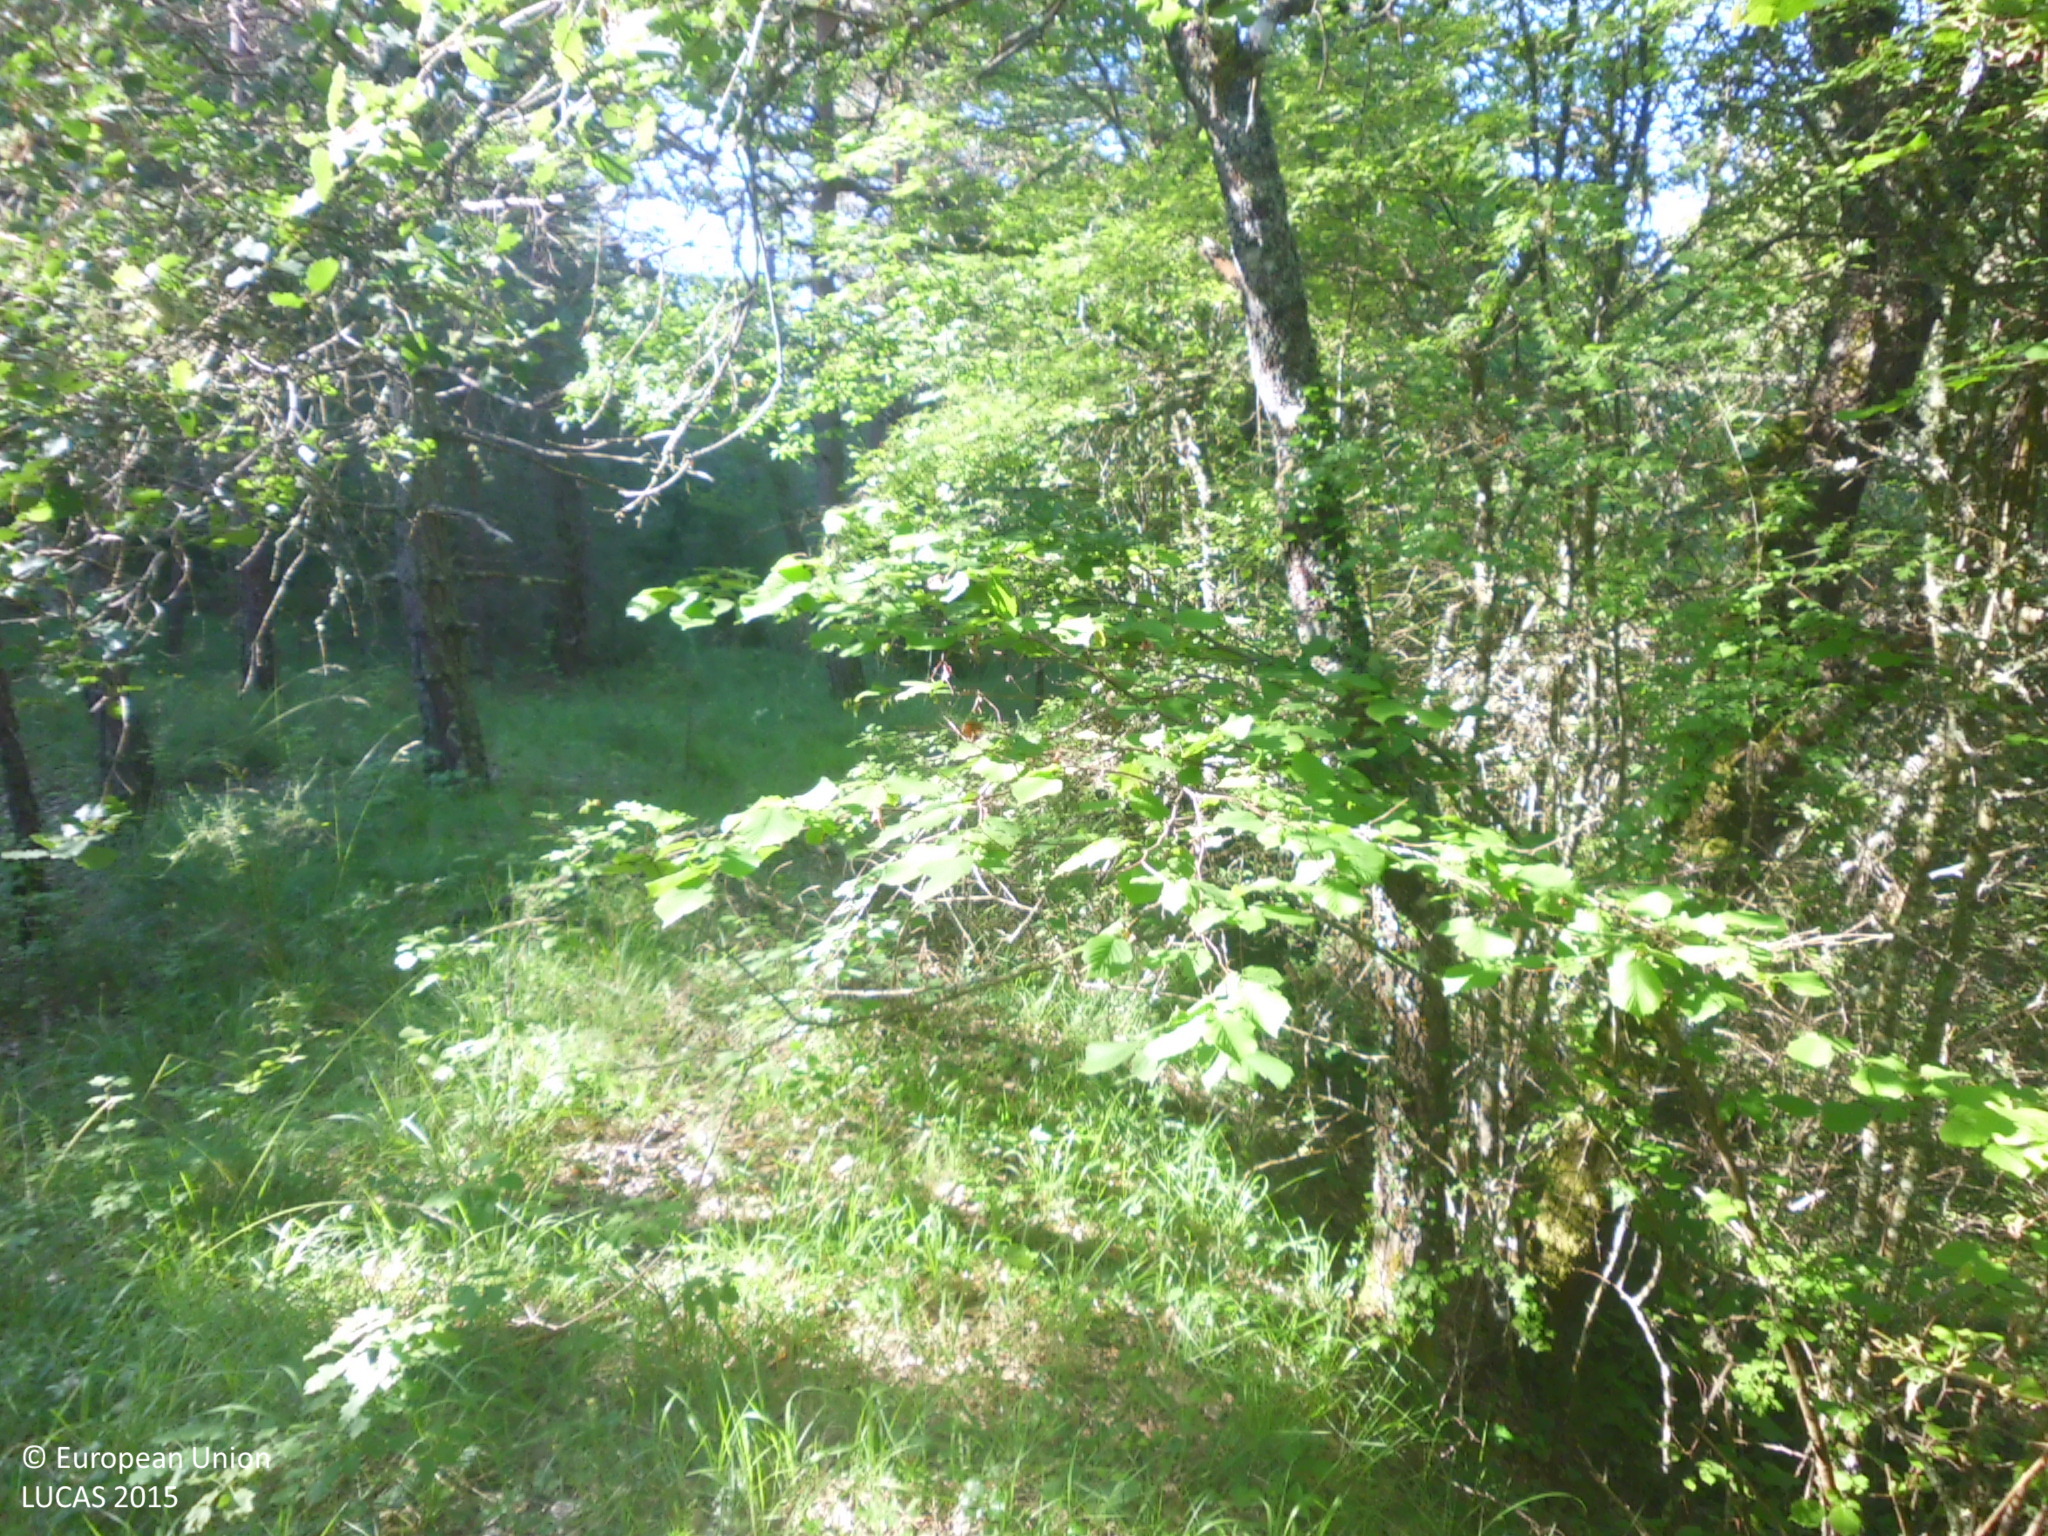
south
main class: Woodland
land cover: Pine dominated mixed woodland
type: coniferous forest of the mediterranean region
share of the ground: 50 - 75 %
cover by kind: coniferous forest trees 40 %, broadleaved forest trees 25 %, herbaceous plants 20 %, shrubs 15 %
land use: Forestry
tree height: > 5 m
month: June
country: ES
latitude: 42.8991
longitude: -3.3488
